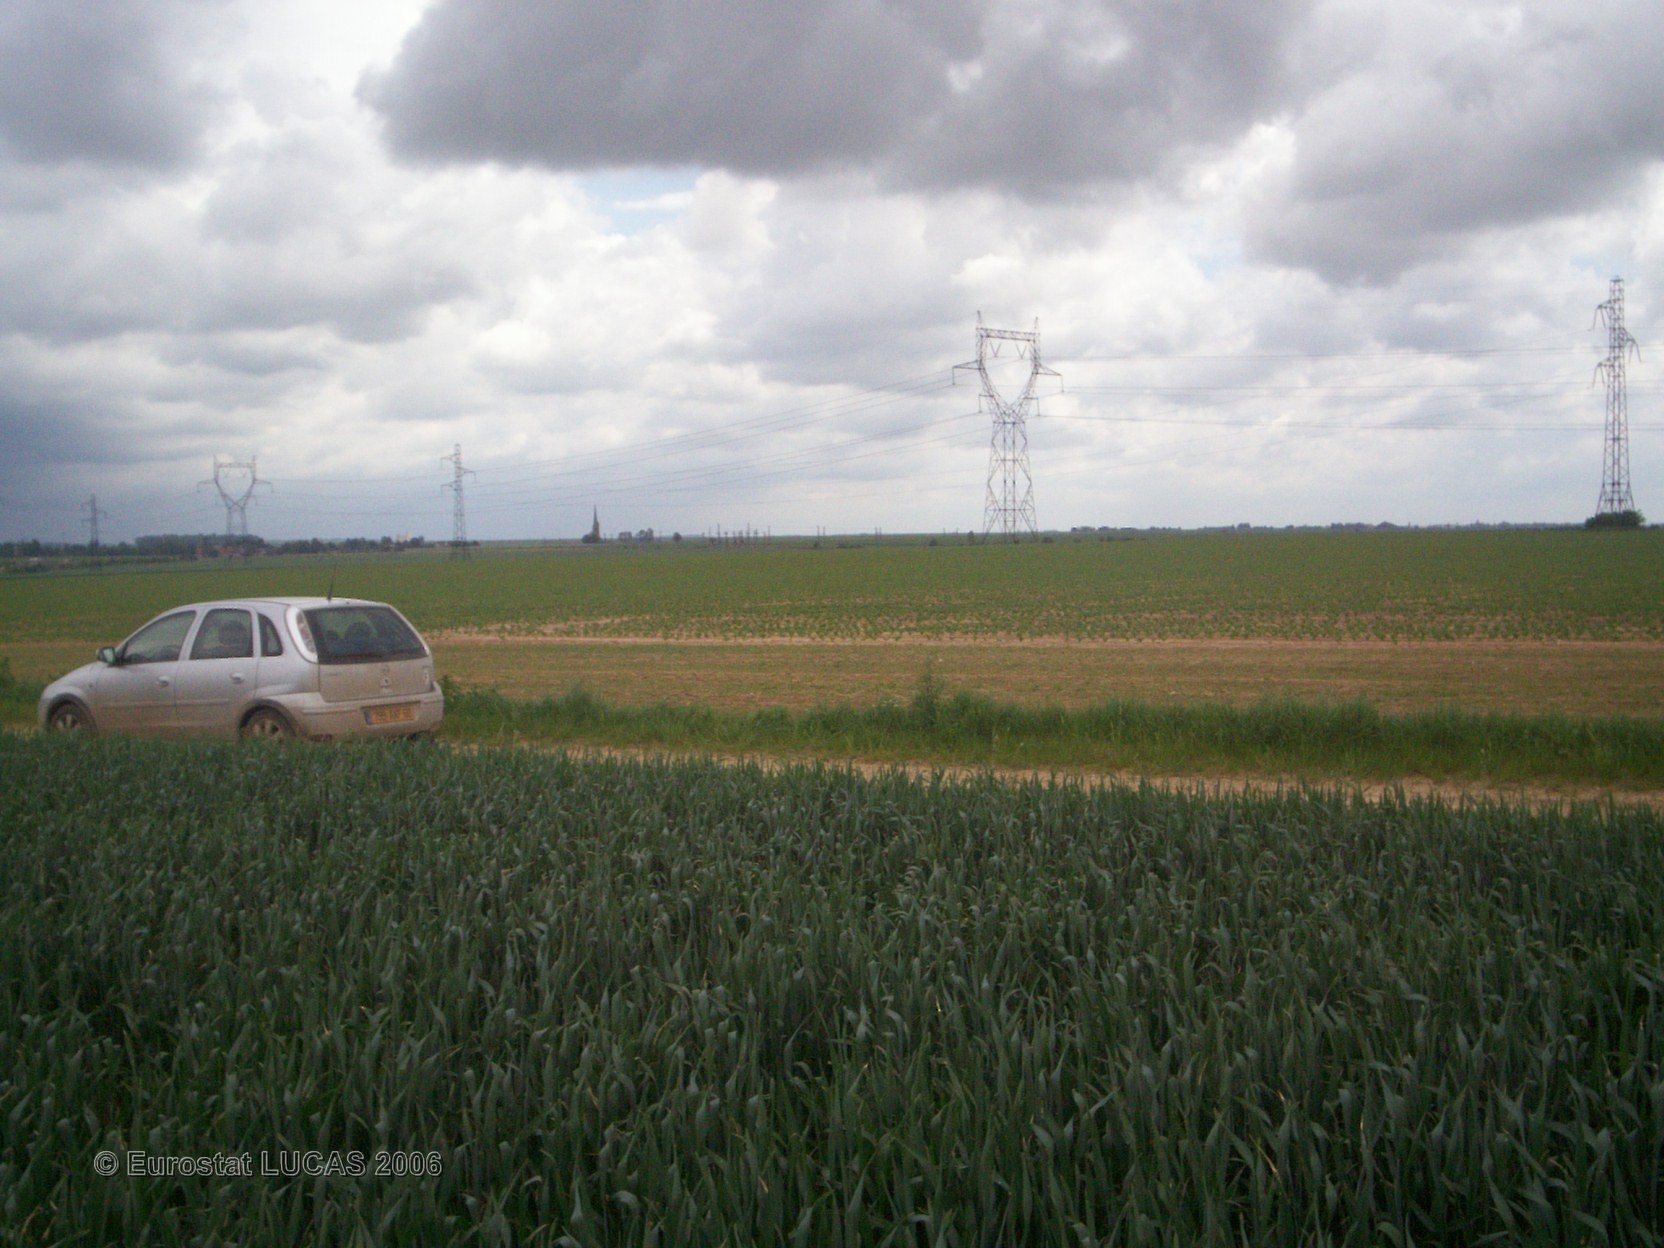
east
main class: Cropland
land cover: Common wheat
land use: Agriculture (excluding fallow land and kitchen gardens)
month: May
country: FR
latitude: 49.1203
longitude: 2.7138
